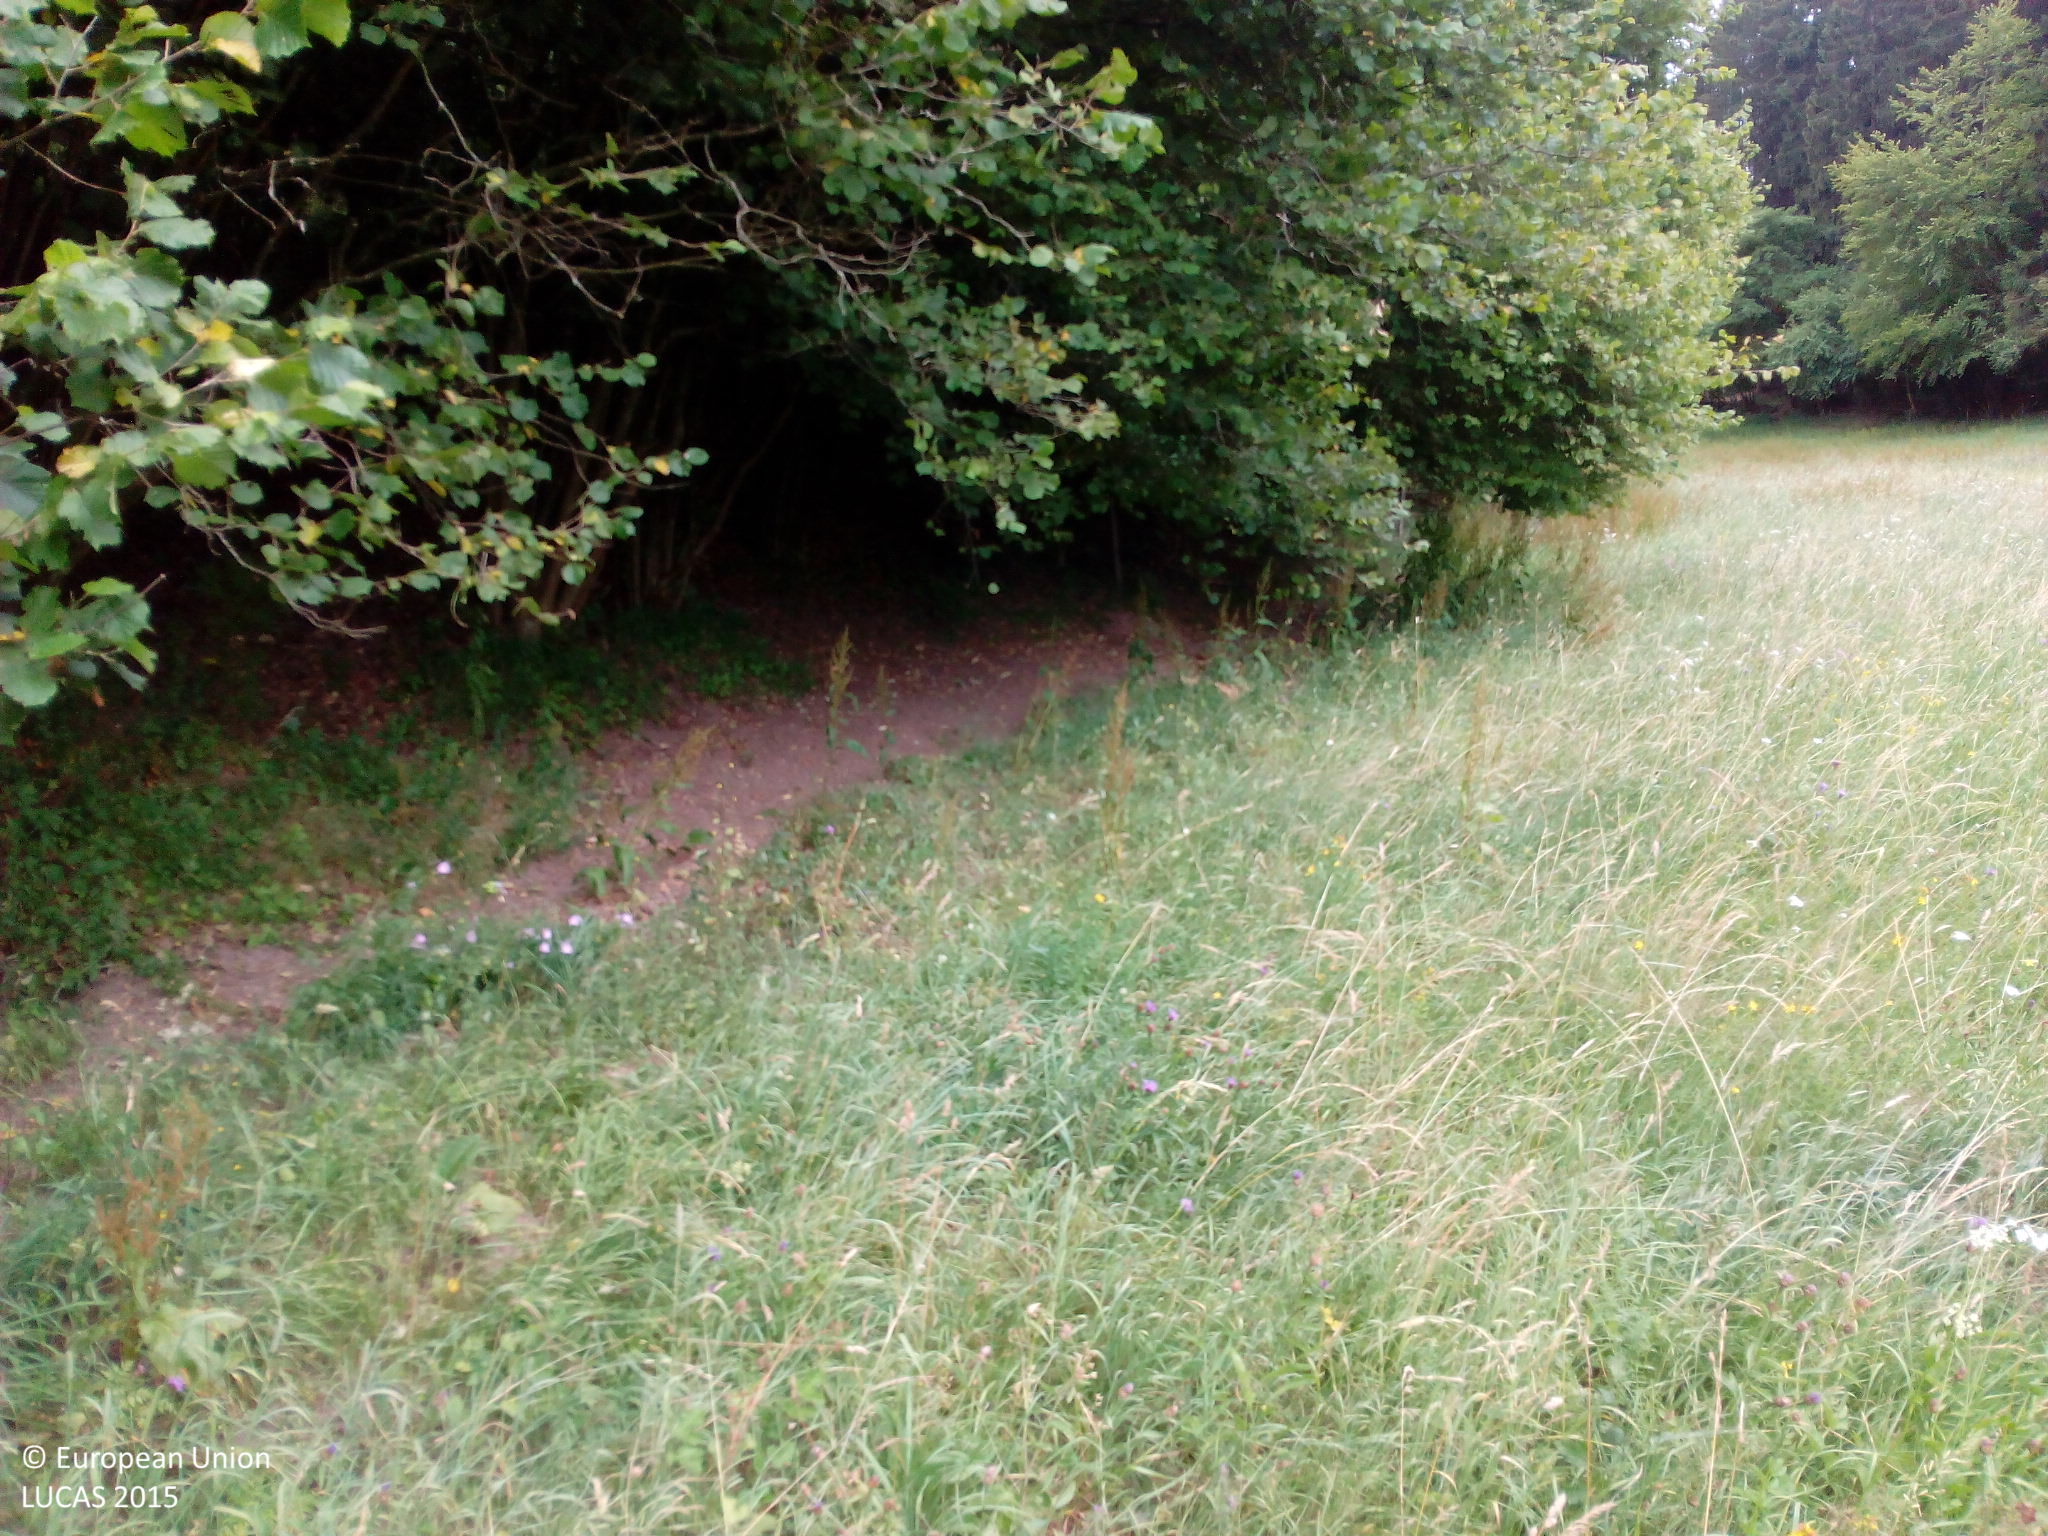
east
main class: Grassland
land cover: Grassland without tree/shrub cover
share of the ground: > 75 %
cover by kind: herbaceous plants 100 %
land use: Agriculture (excluding fallow land and kitchen gardens)
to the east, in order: Grassland without tree/shrub cover; Broadleaved woodland; Fences; Broadleaved woodland; Electric lines; Tracks; Broadleaved woodland
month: July
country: DE
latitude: 49.5531
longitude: 7.0836
